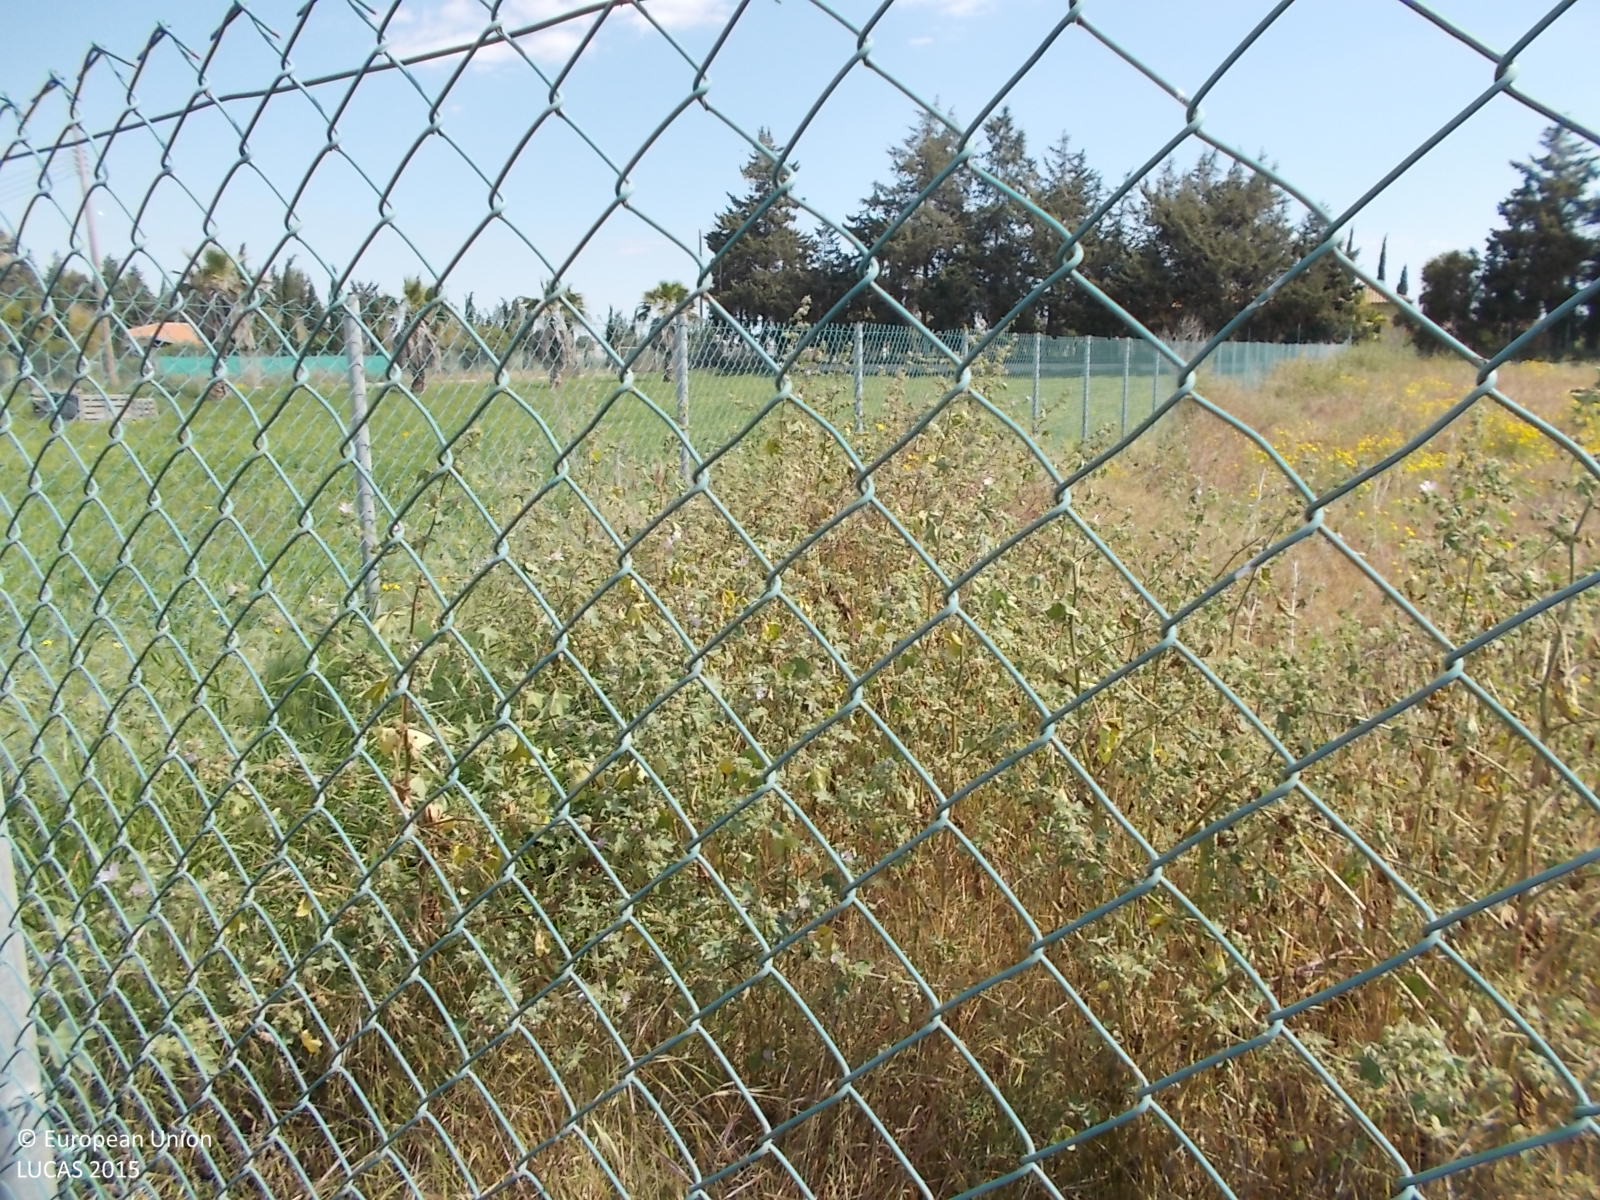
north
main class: Grassland
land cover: Grassland without tree/shrub cover
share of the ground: > 75 %
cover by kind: herbaceous plants 100 %
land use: Agriculture (excluding fallow land and kitchen gardens)
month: April
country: CY
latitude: 34.8369
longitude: 33.5590
